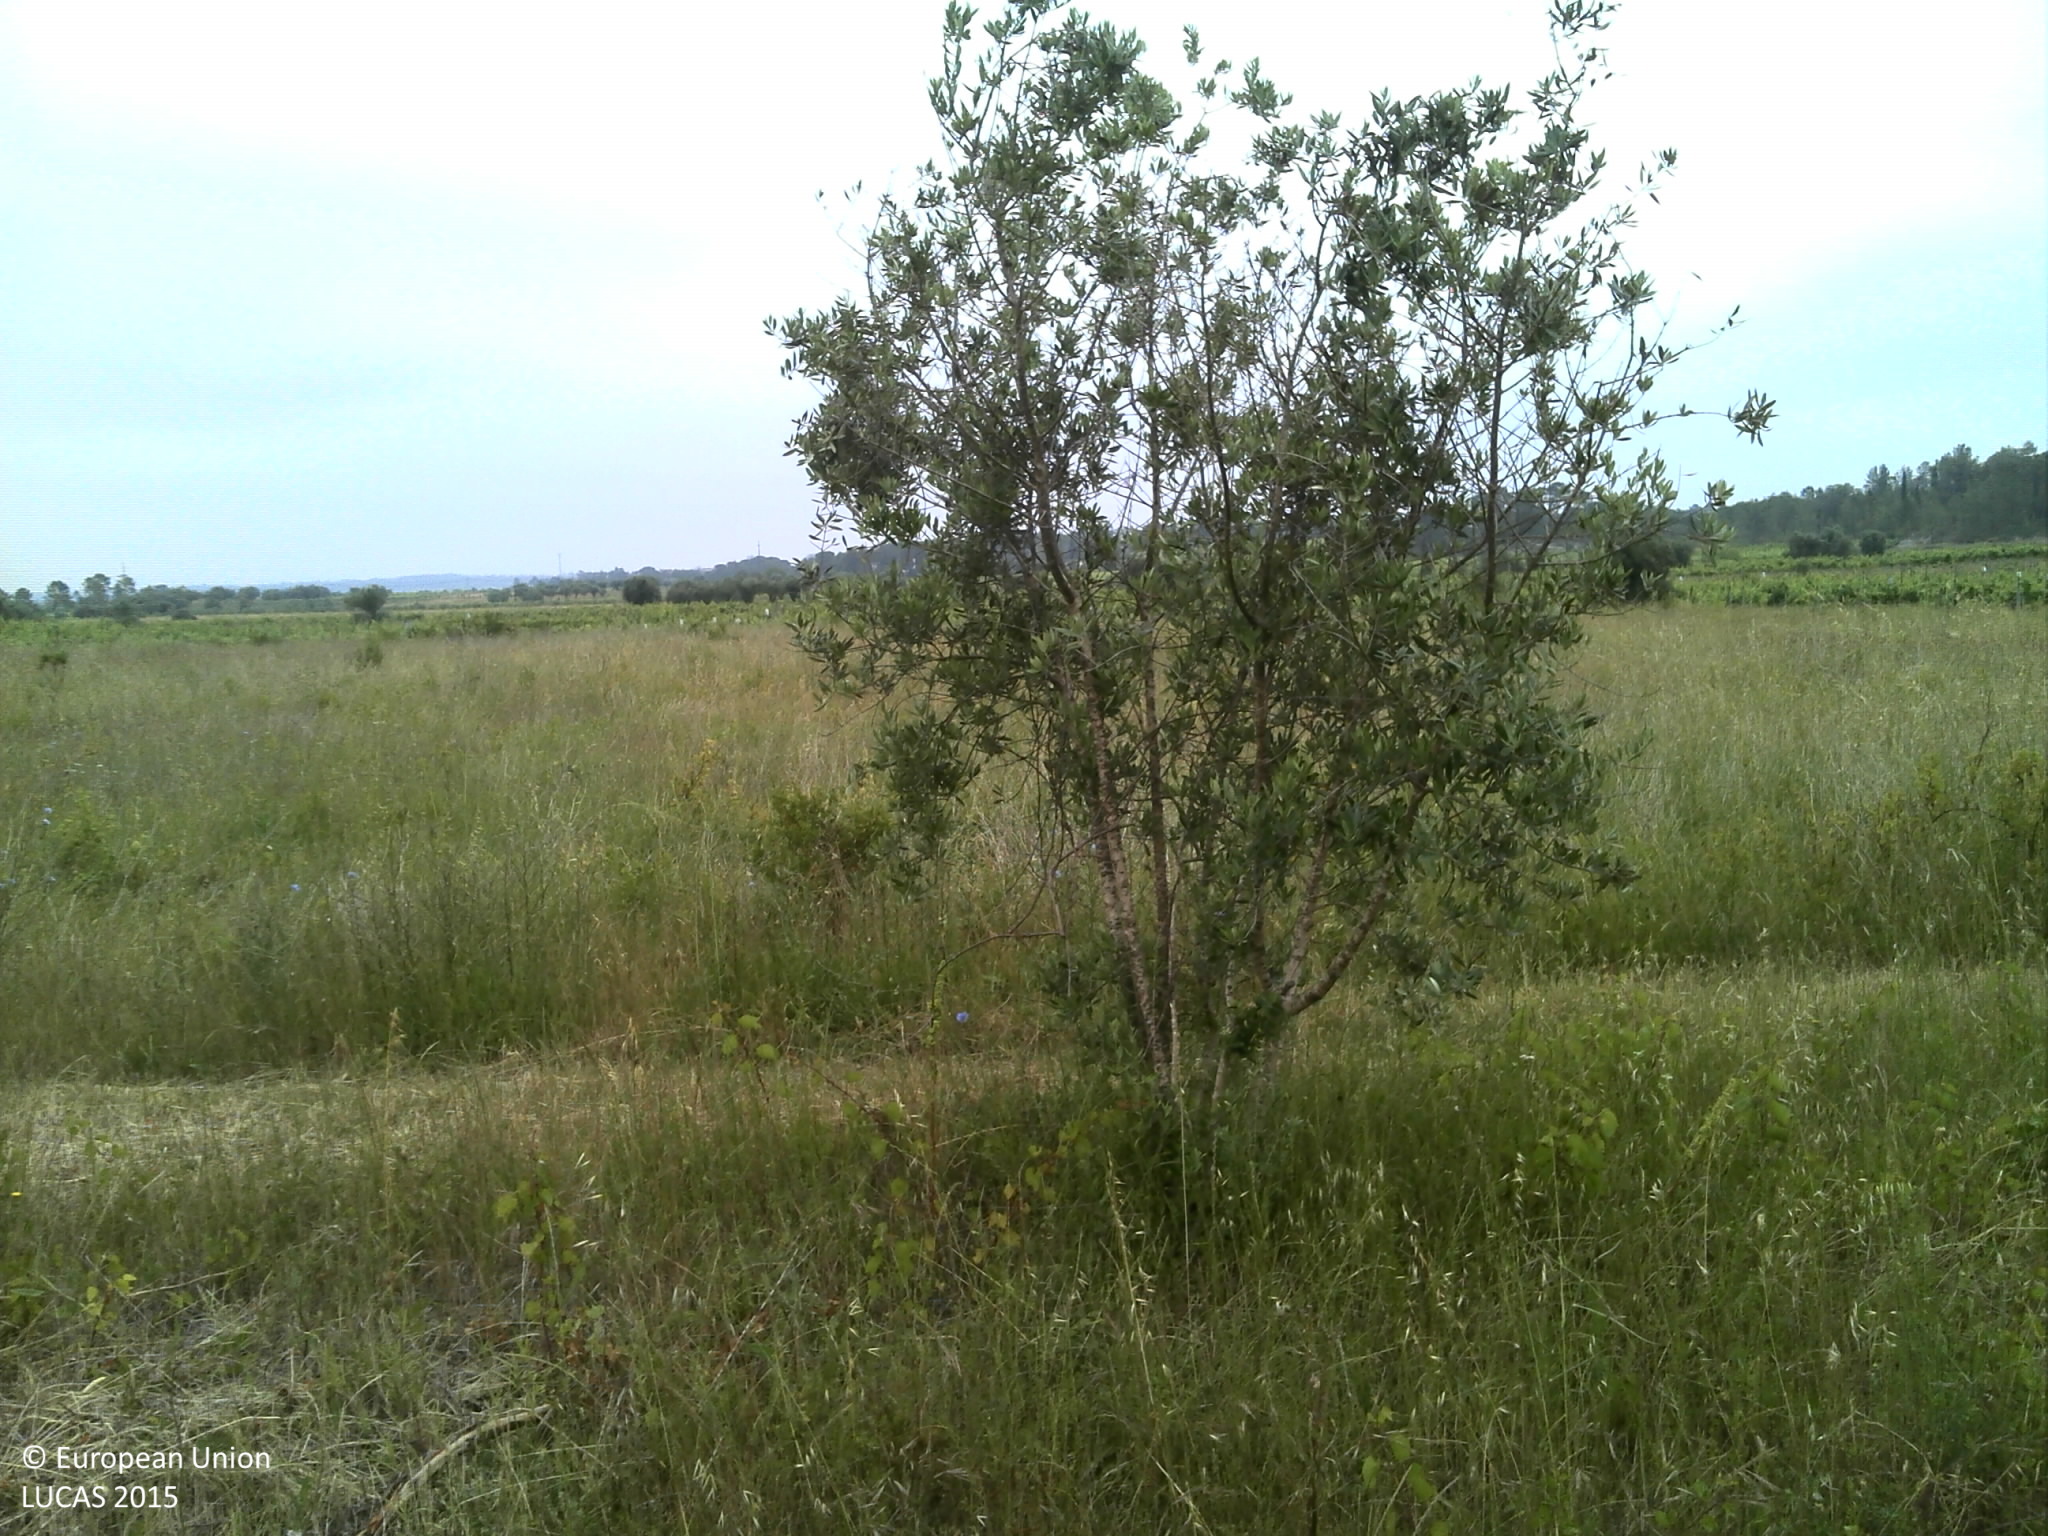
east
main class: Cropland
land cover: Vineyards
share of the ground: 10 - 25 %
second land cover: Grassland without tree/shrub cover
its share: 50 - 75 %
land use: Abandoned areas
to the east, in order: Vineyards; Grassland without tree/shrub cover; Single bushes/trees; Tracks; Grassland without tree/shrub cover; Vineyards; Single bushes/trees; Spontaneously vegetated surfaces; Vineyards; Maize; Vineyards; Spontaneously vegetated surfaces; Vineyards
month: June
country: PT
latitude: 40.3208
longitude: -8.6024
